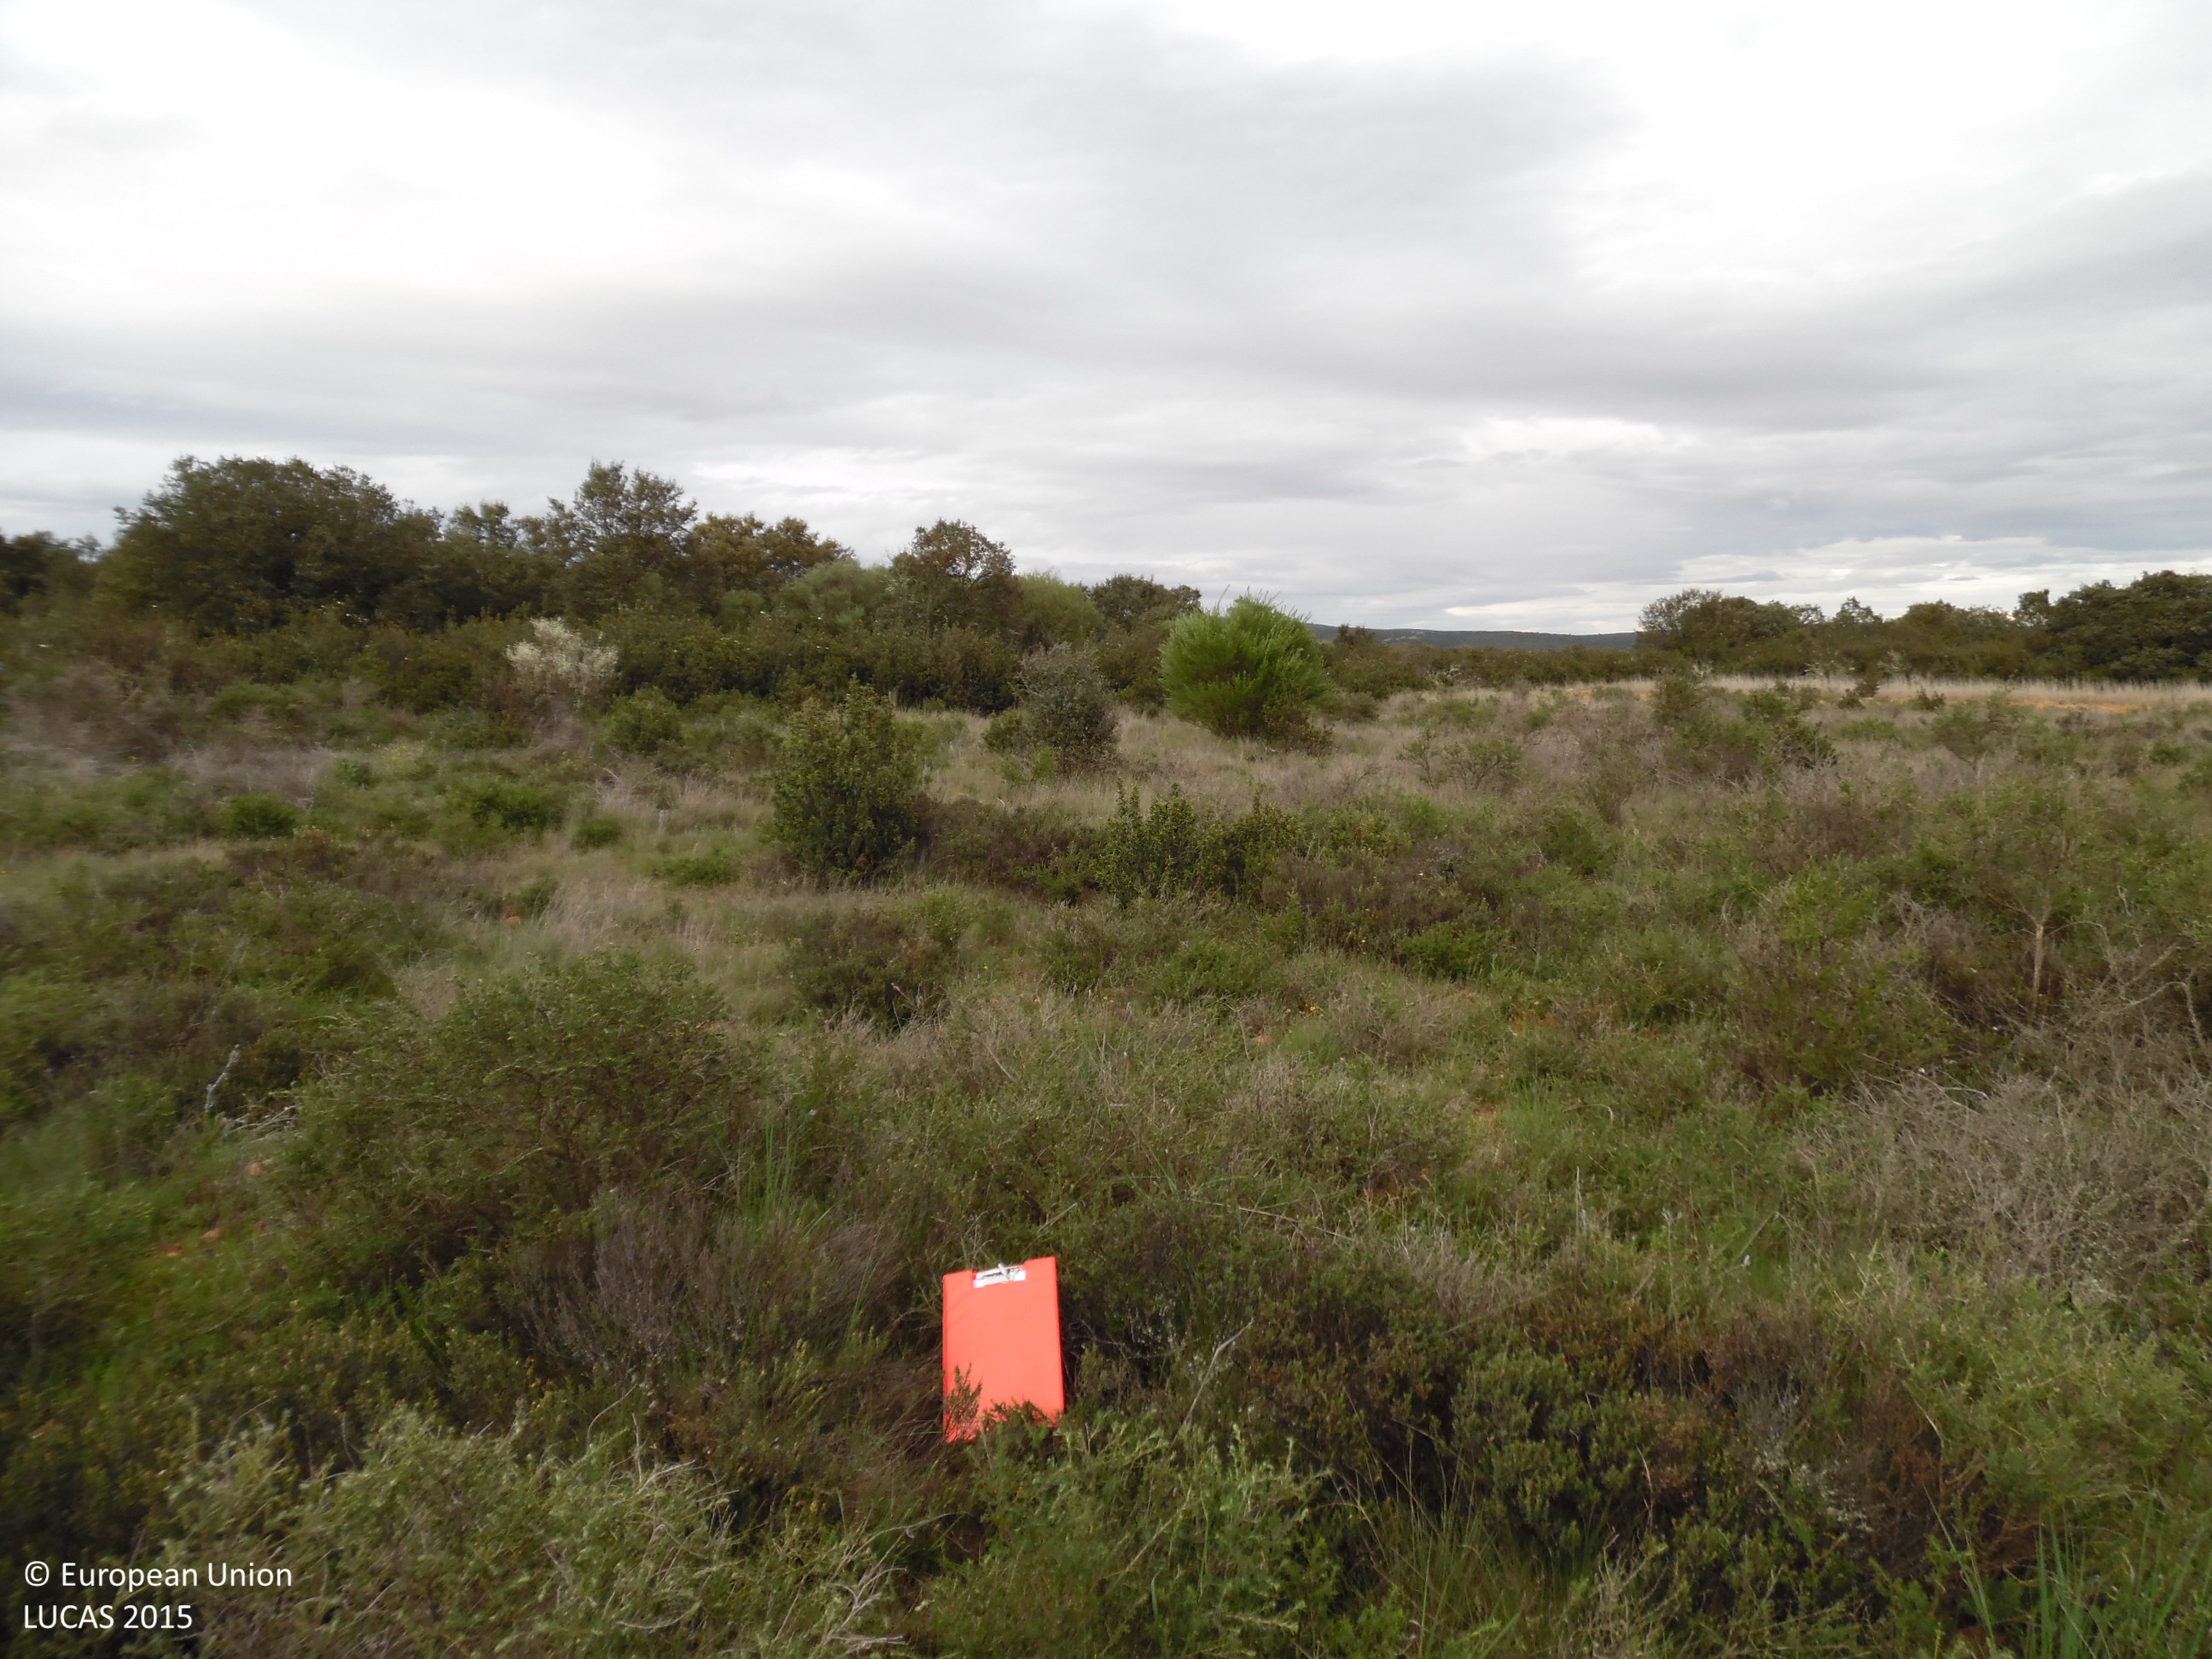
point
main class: Shrubland
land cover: Shrubland without tree cover
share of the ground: > 75 %
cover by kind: shrubs 100 %
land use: Abandoned areas
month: April
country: ES
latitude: 42.1813
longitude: -5.9977
